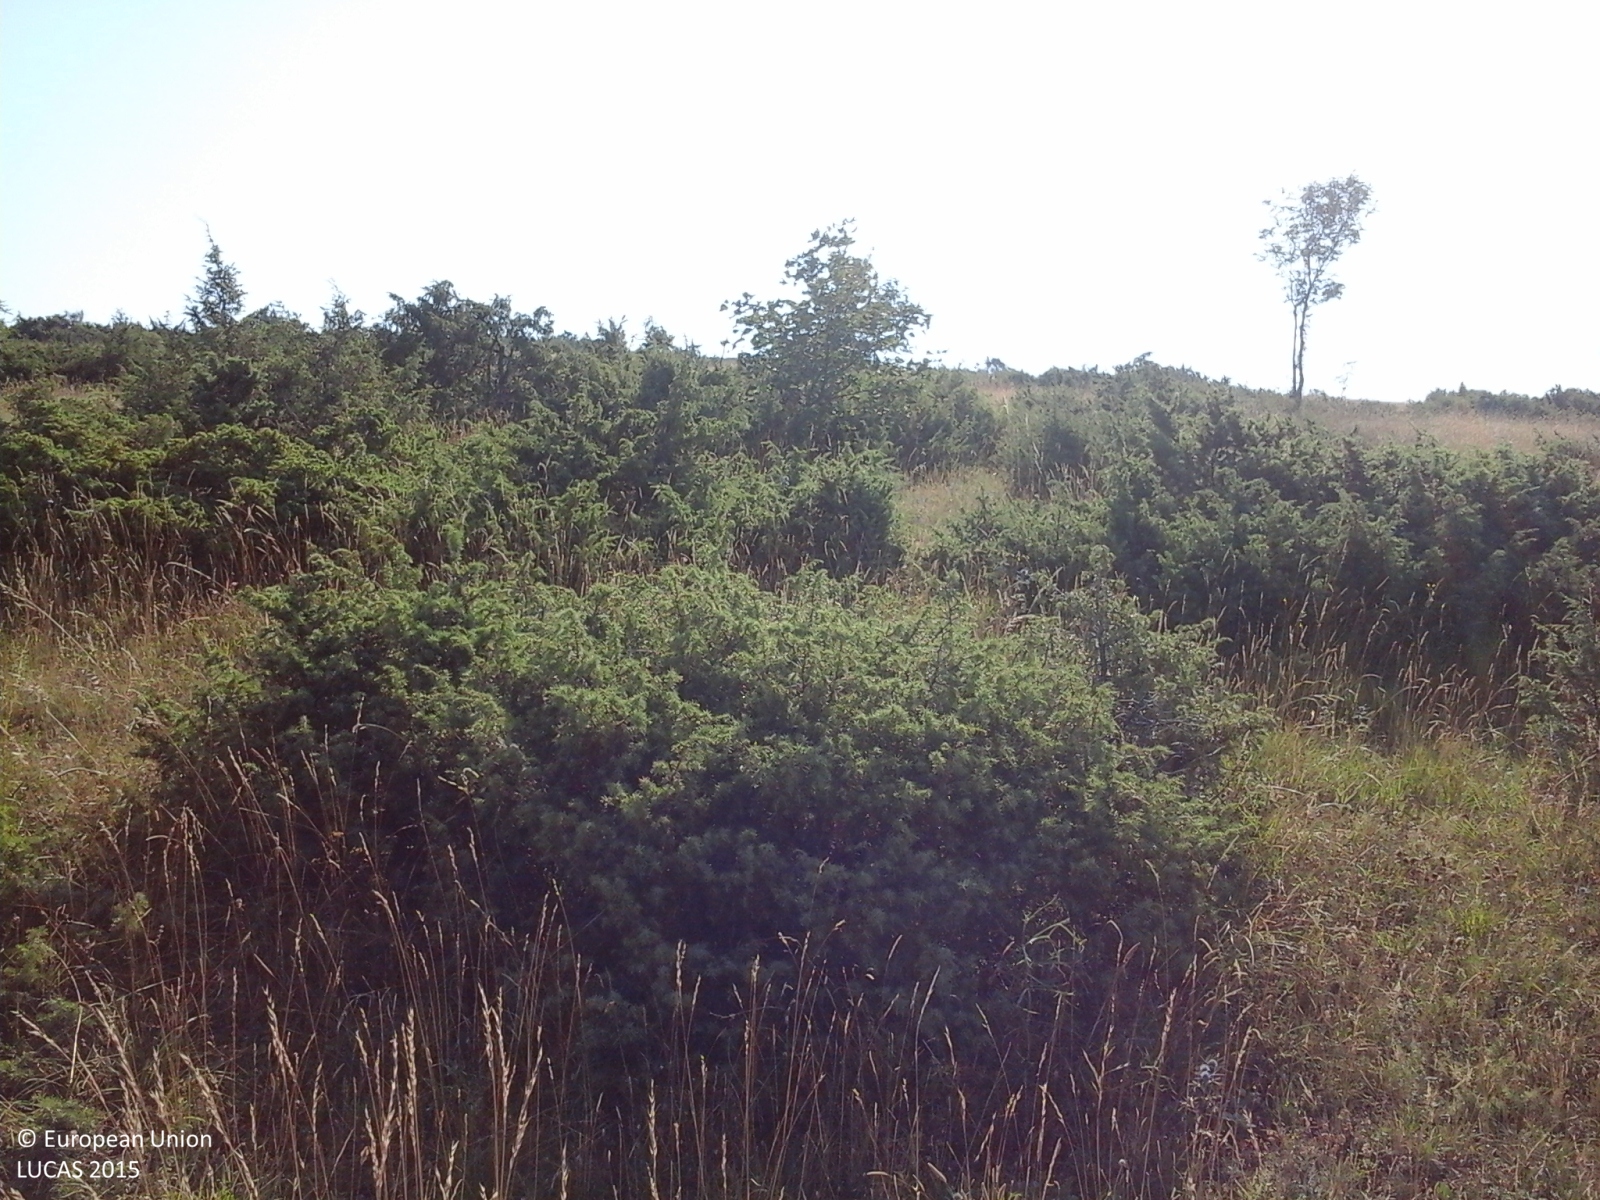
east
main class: Shrubland
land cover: Shrubland with sparse tree cover
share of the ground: > 75 %
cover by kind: herbaceous plants 60 %, shrubs 35 %, coniferous forest trees 5 %
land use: Agriculture (excluding fallow land and kitchen gardens)
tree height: < 5 m
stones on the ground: > 50 %
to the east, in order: Shrubland with sparse tree cover; Shrubland without tree cover; Tracks; Shrubland without tree cover
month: August
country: IT
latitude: 43.0742
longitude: 13.1721
